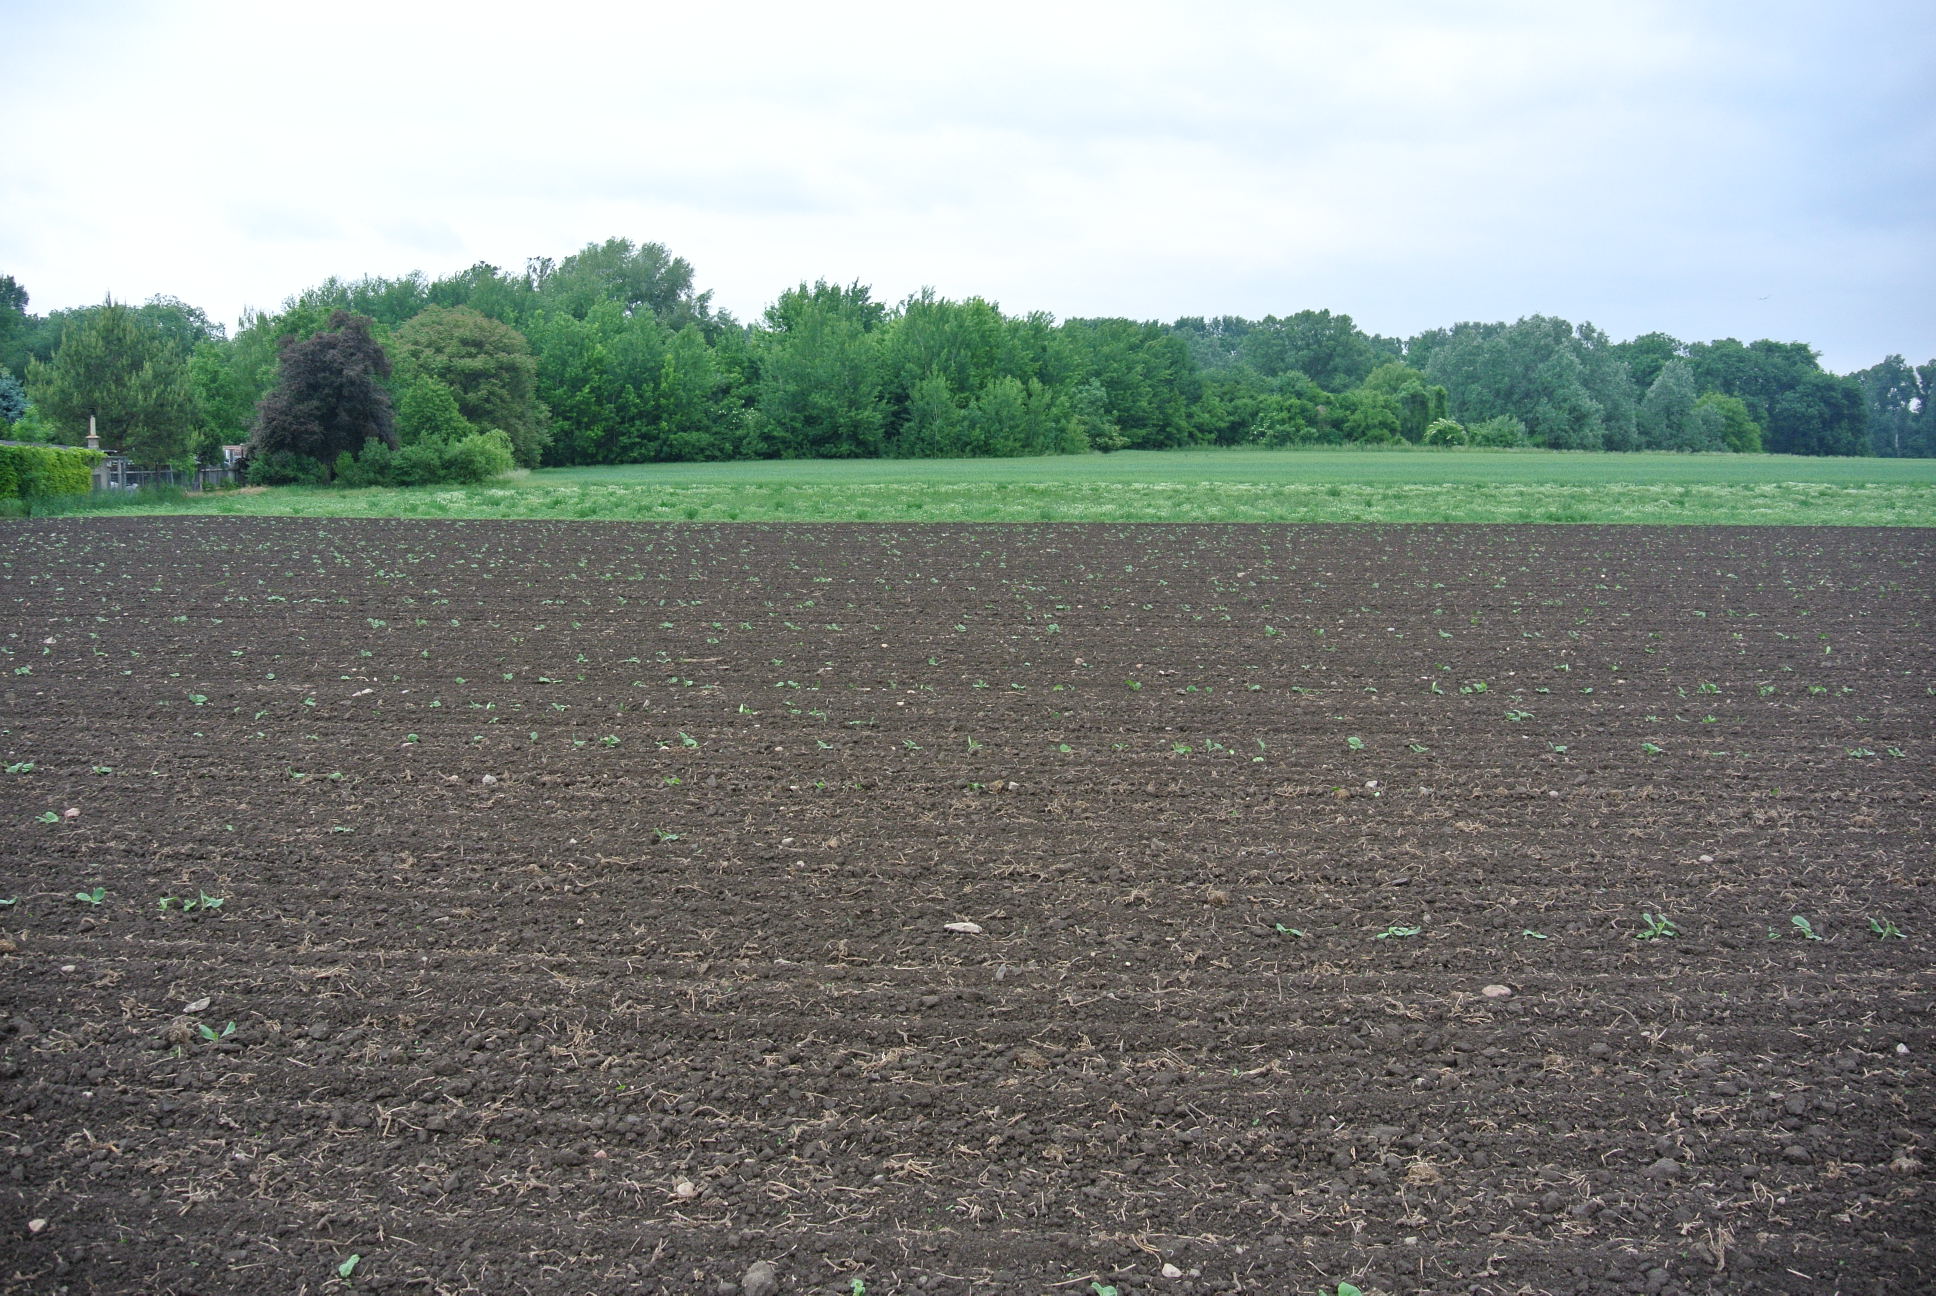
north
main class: Cropland
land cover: Other fibre and oleaginous crops
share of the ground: < 10 %
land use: Agriculture (excluding fallow land and kitchen gardens)
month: May
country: AT
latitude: 48.0084
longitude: 16.5871
